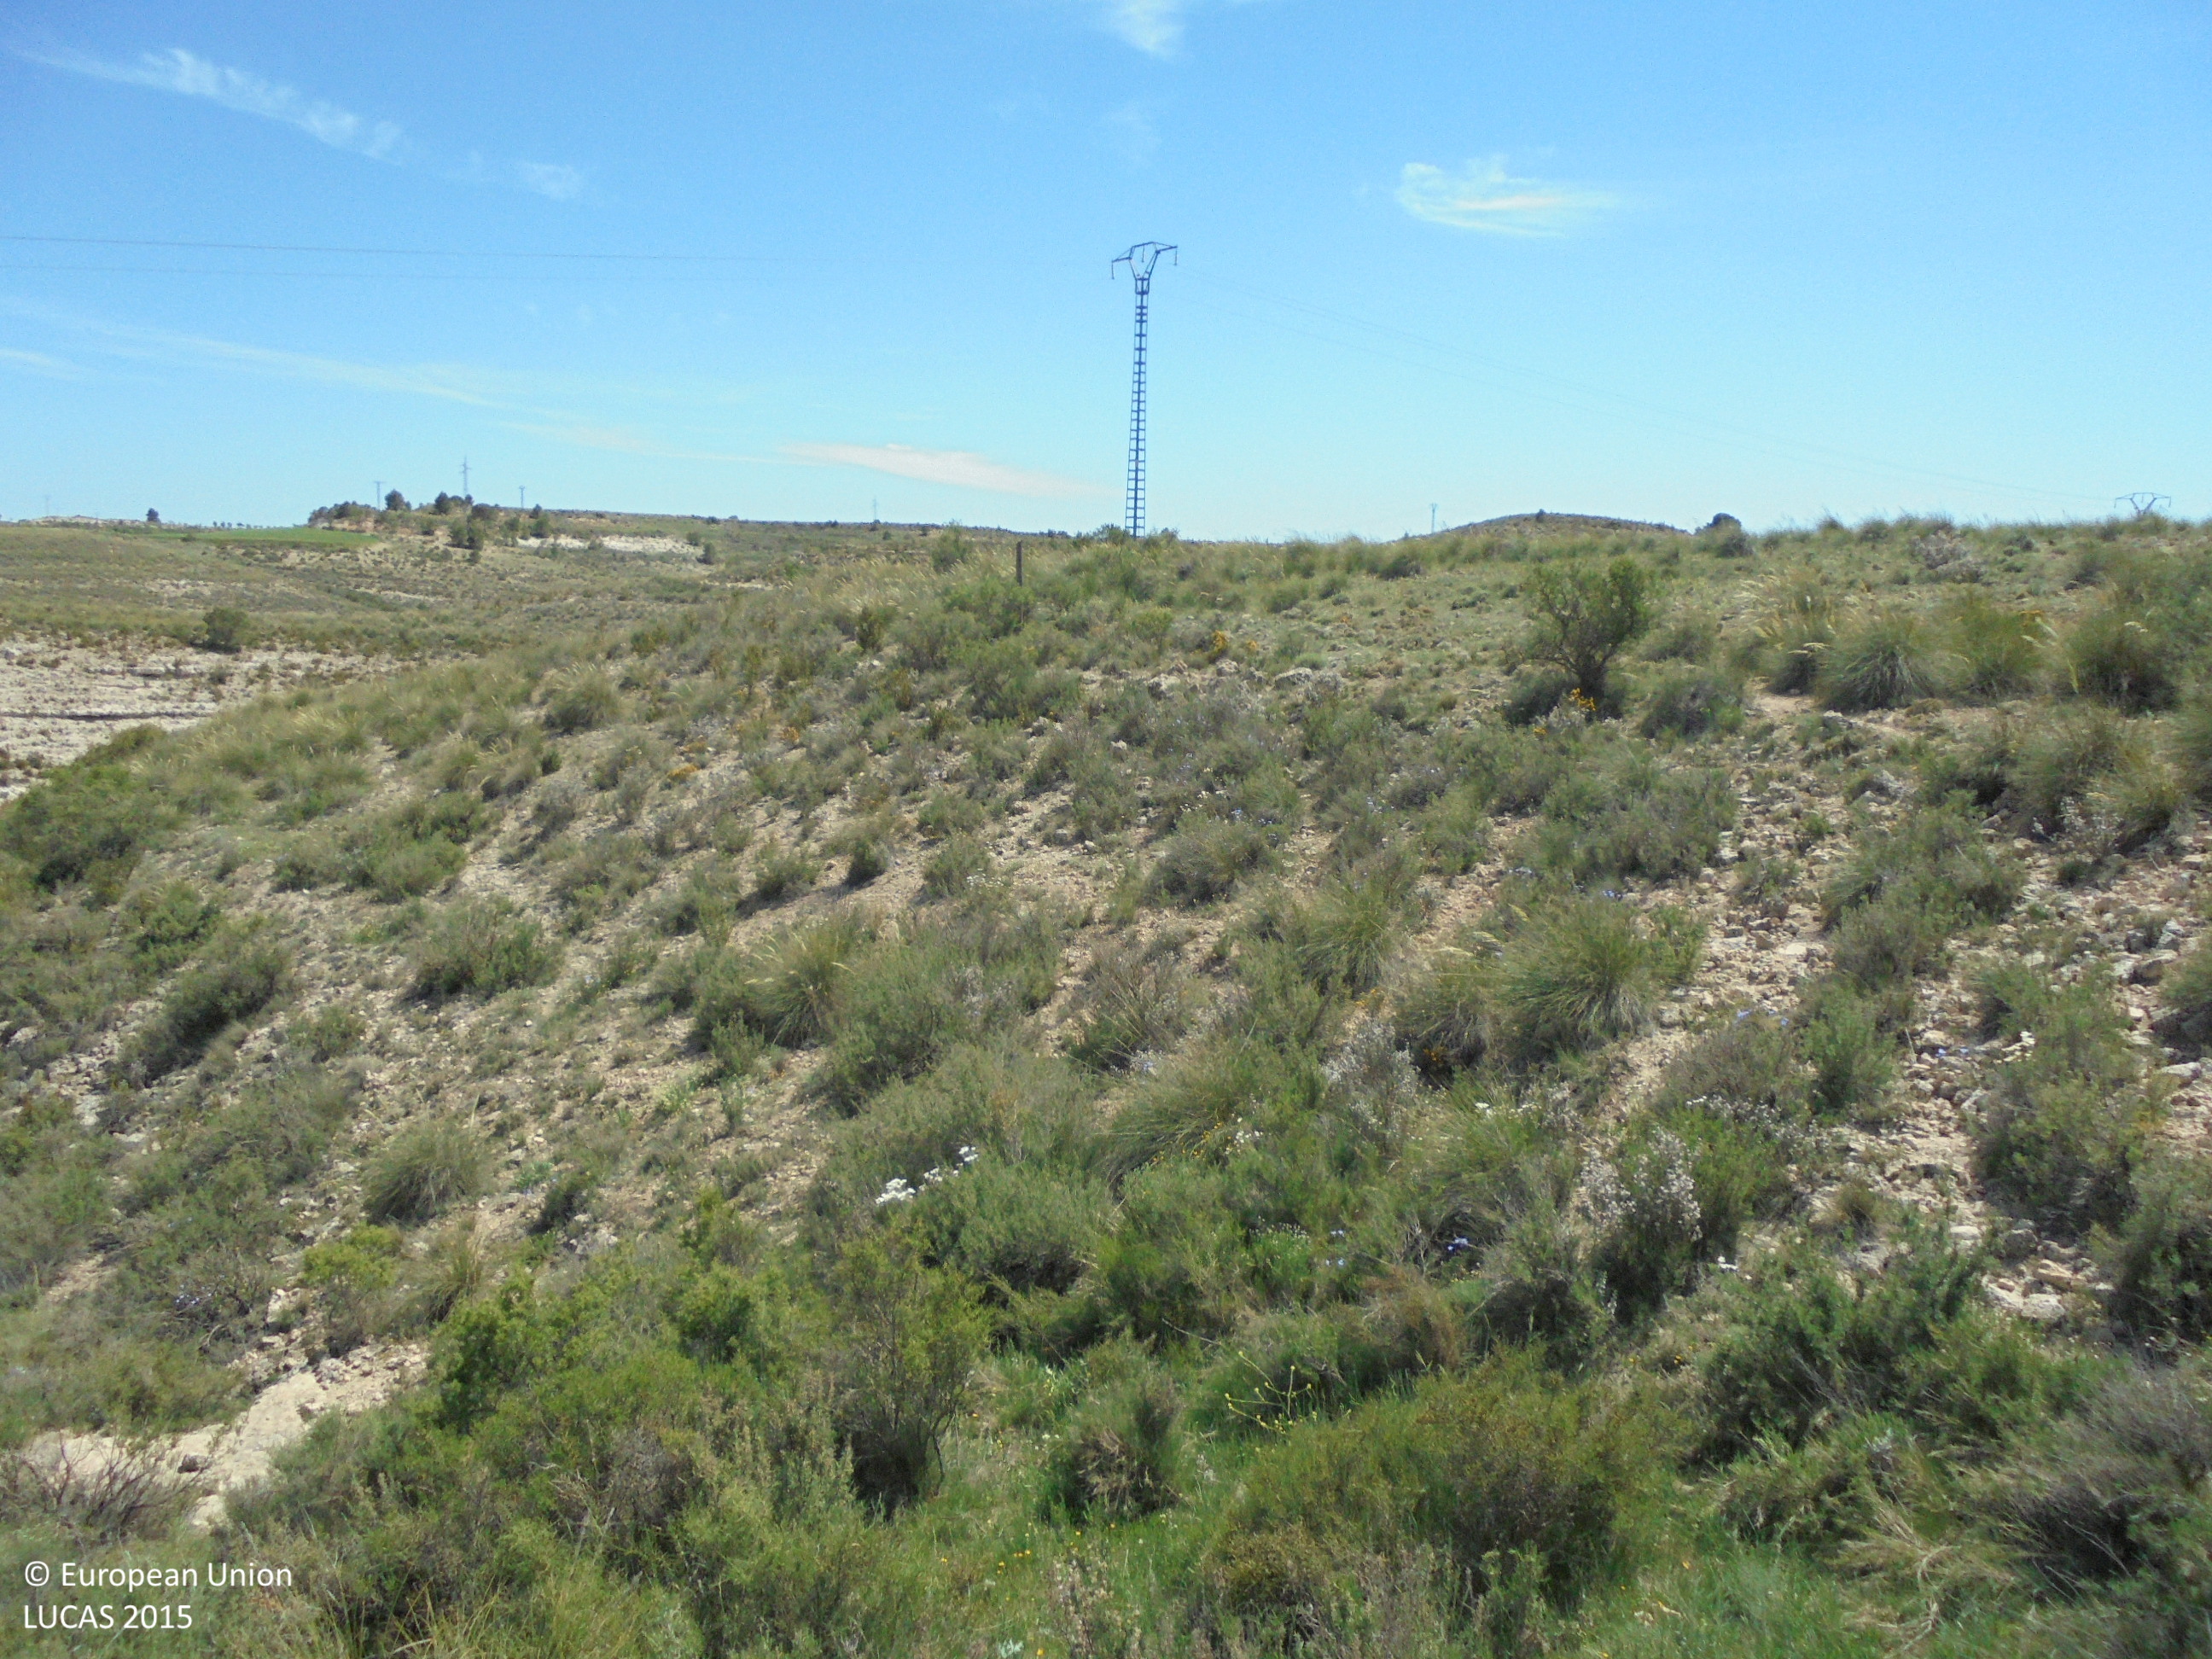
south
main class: Shrubland
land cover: Shrubland without tree cover
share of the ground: 50 - 75 %
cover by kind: shrubs 50 %, consolidated bare surface 35 %, herbaceous plants 15 %
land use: Semi-natural and natural areas not in use
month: May
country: ES
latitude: 39.1530
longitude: -1.6303
